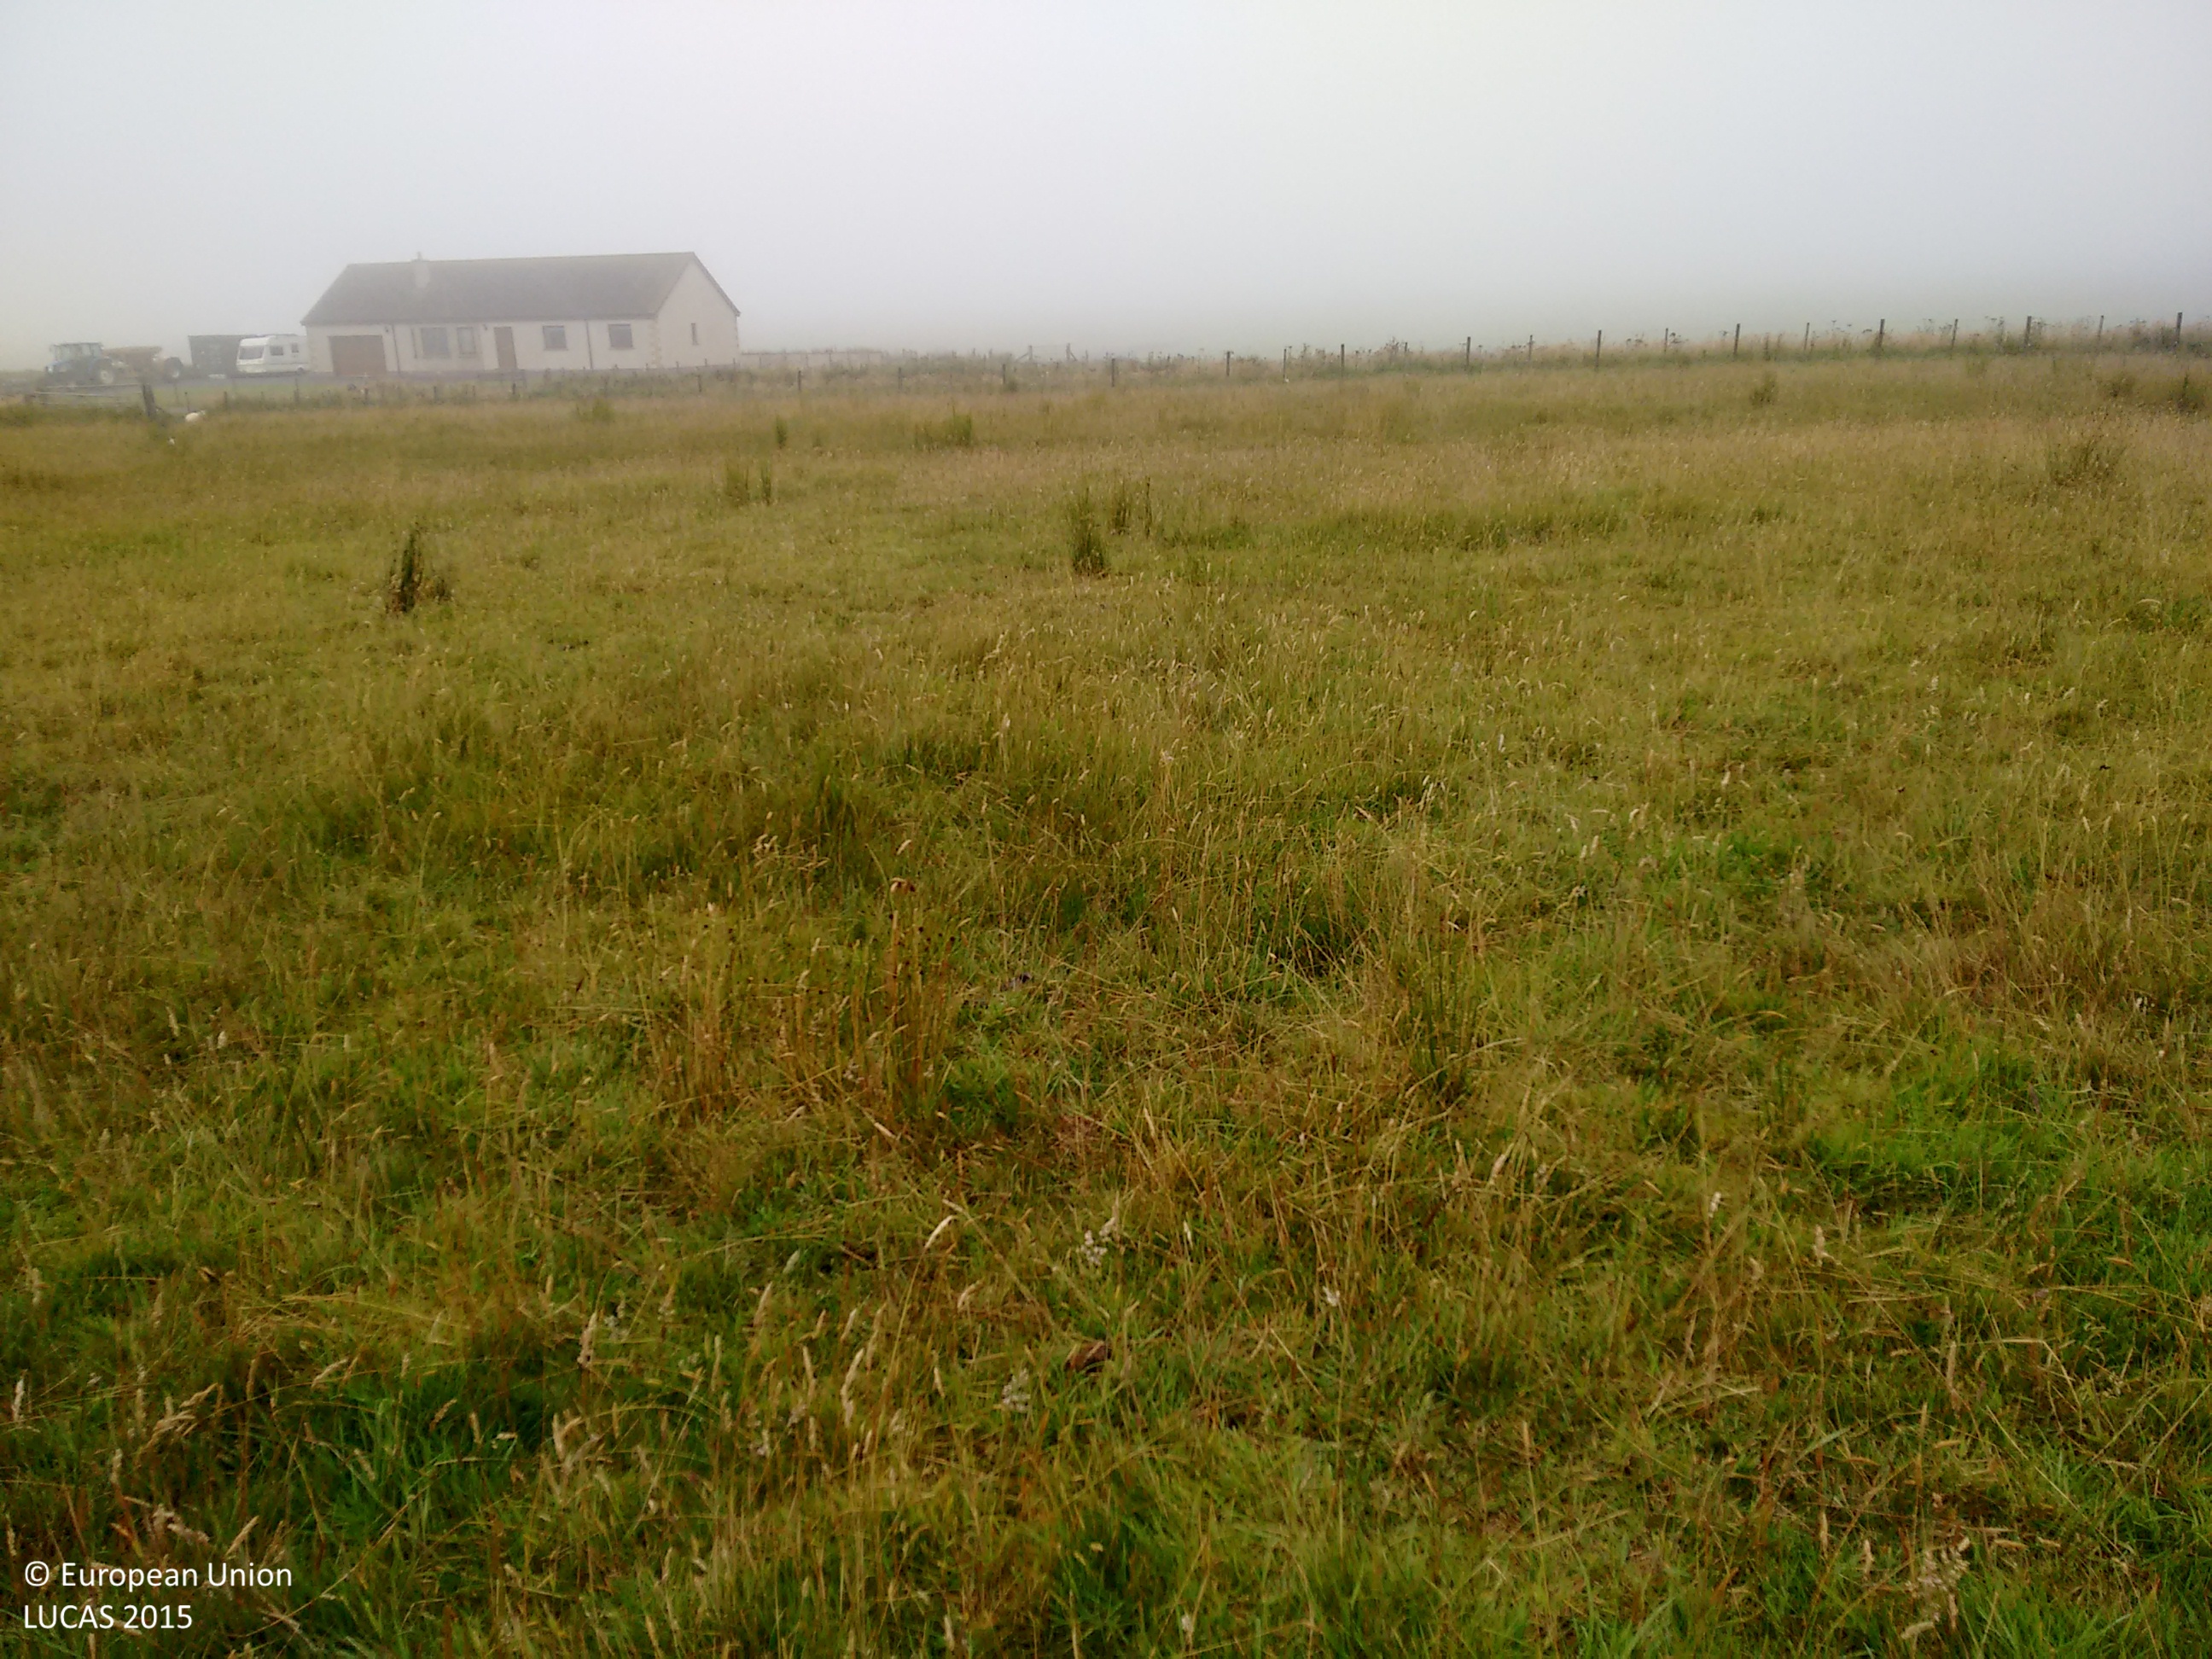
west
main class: Grassland
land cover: Grassland without tree/shrub cover
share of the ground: > 75 %
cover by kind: herbaceous plants 100 %
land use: Agriculture (excluding fallow land and kitchen gardens)
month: August
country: GB
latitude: 58.3259
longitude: -3.2600
